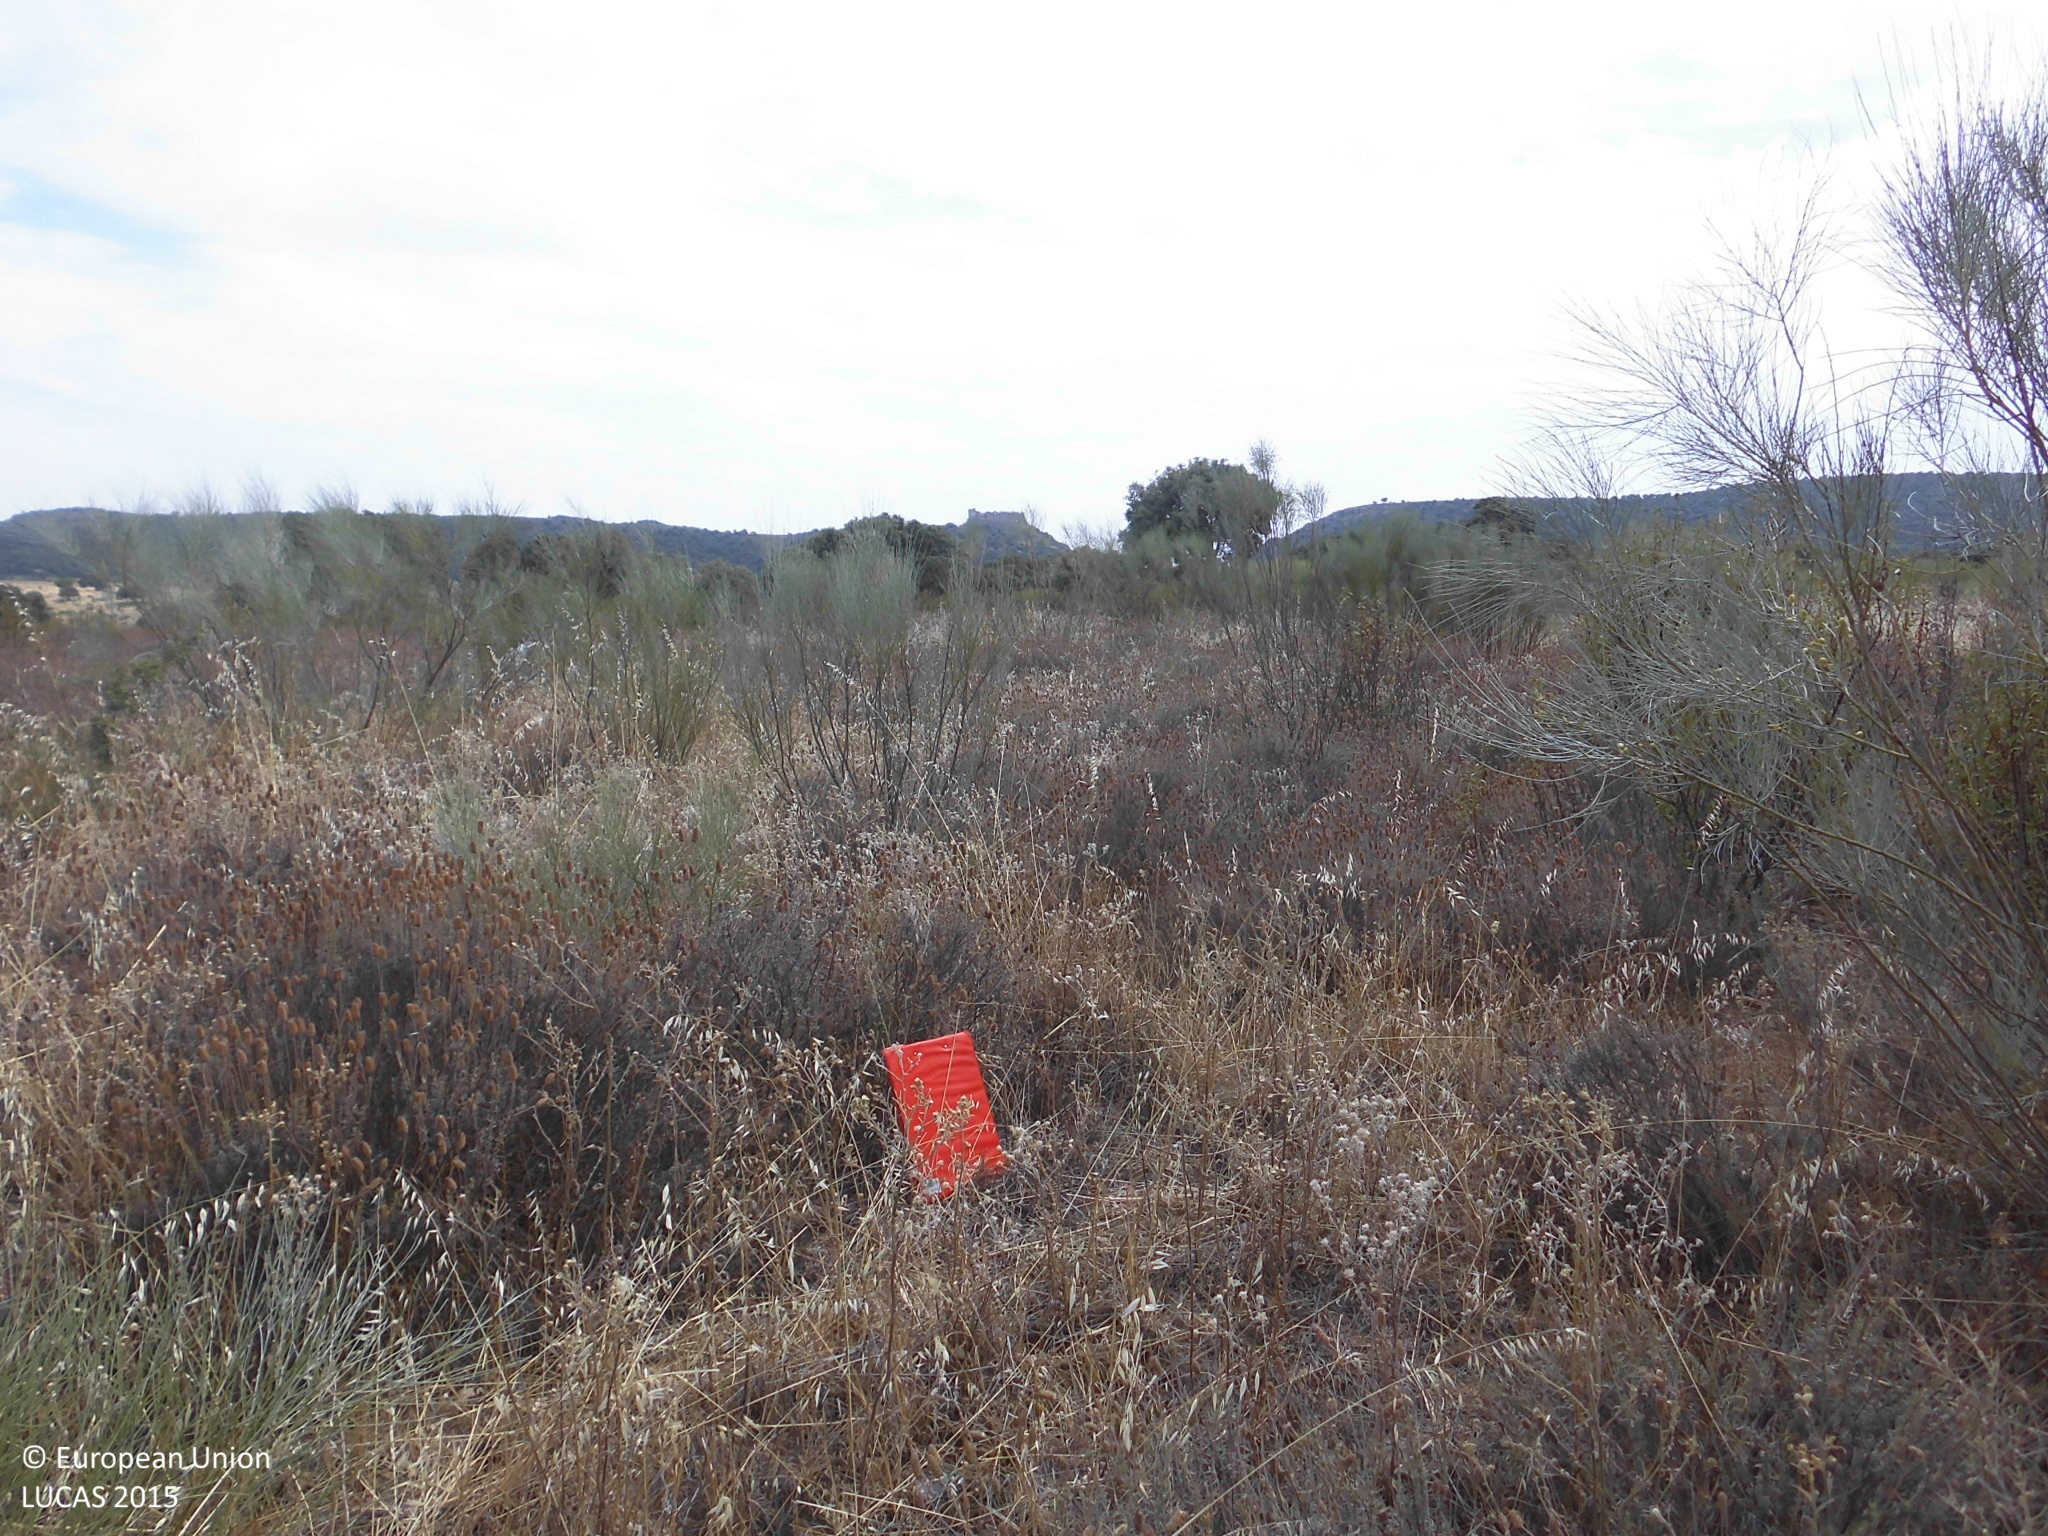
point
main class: Shrubland
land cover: Shrubland with sparse tree cover
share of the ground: 10 - 25 %
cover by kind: herbaceous plants 75 %, shrubs 20 %, broadleaved forest trees 5 %
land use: Agriculture (excluding fallow land and kitchen gardens)
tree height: > 5 m
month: July
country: ES
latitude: 39.8229
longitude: -6.4673
